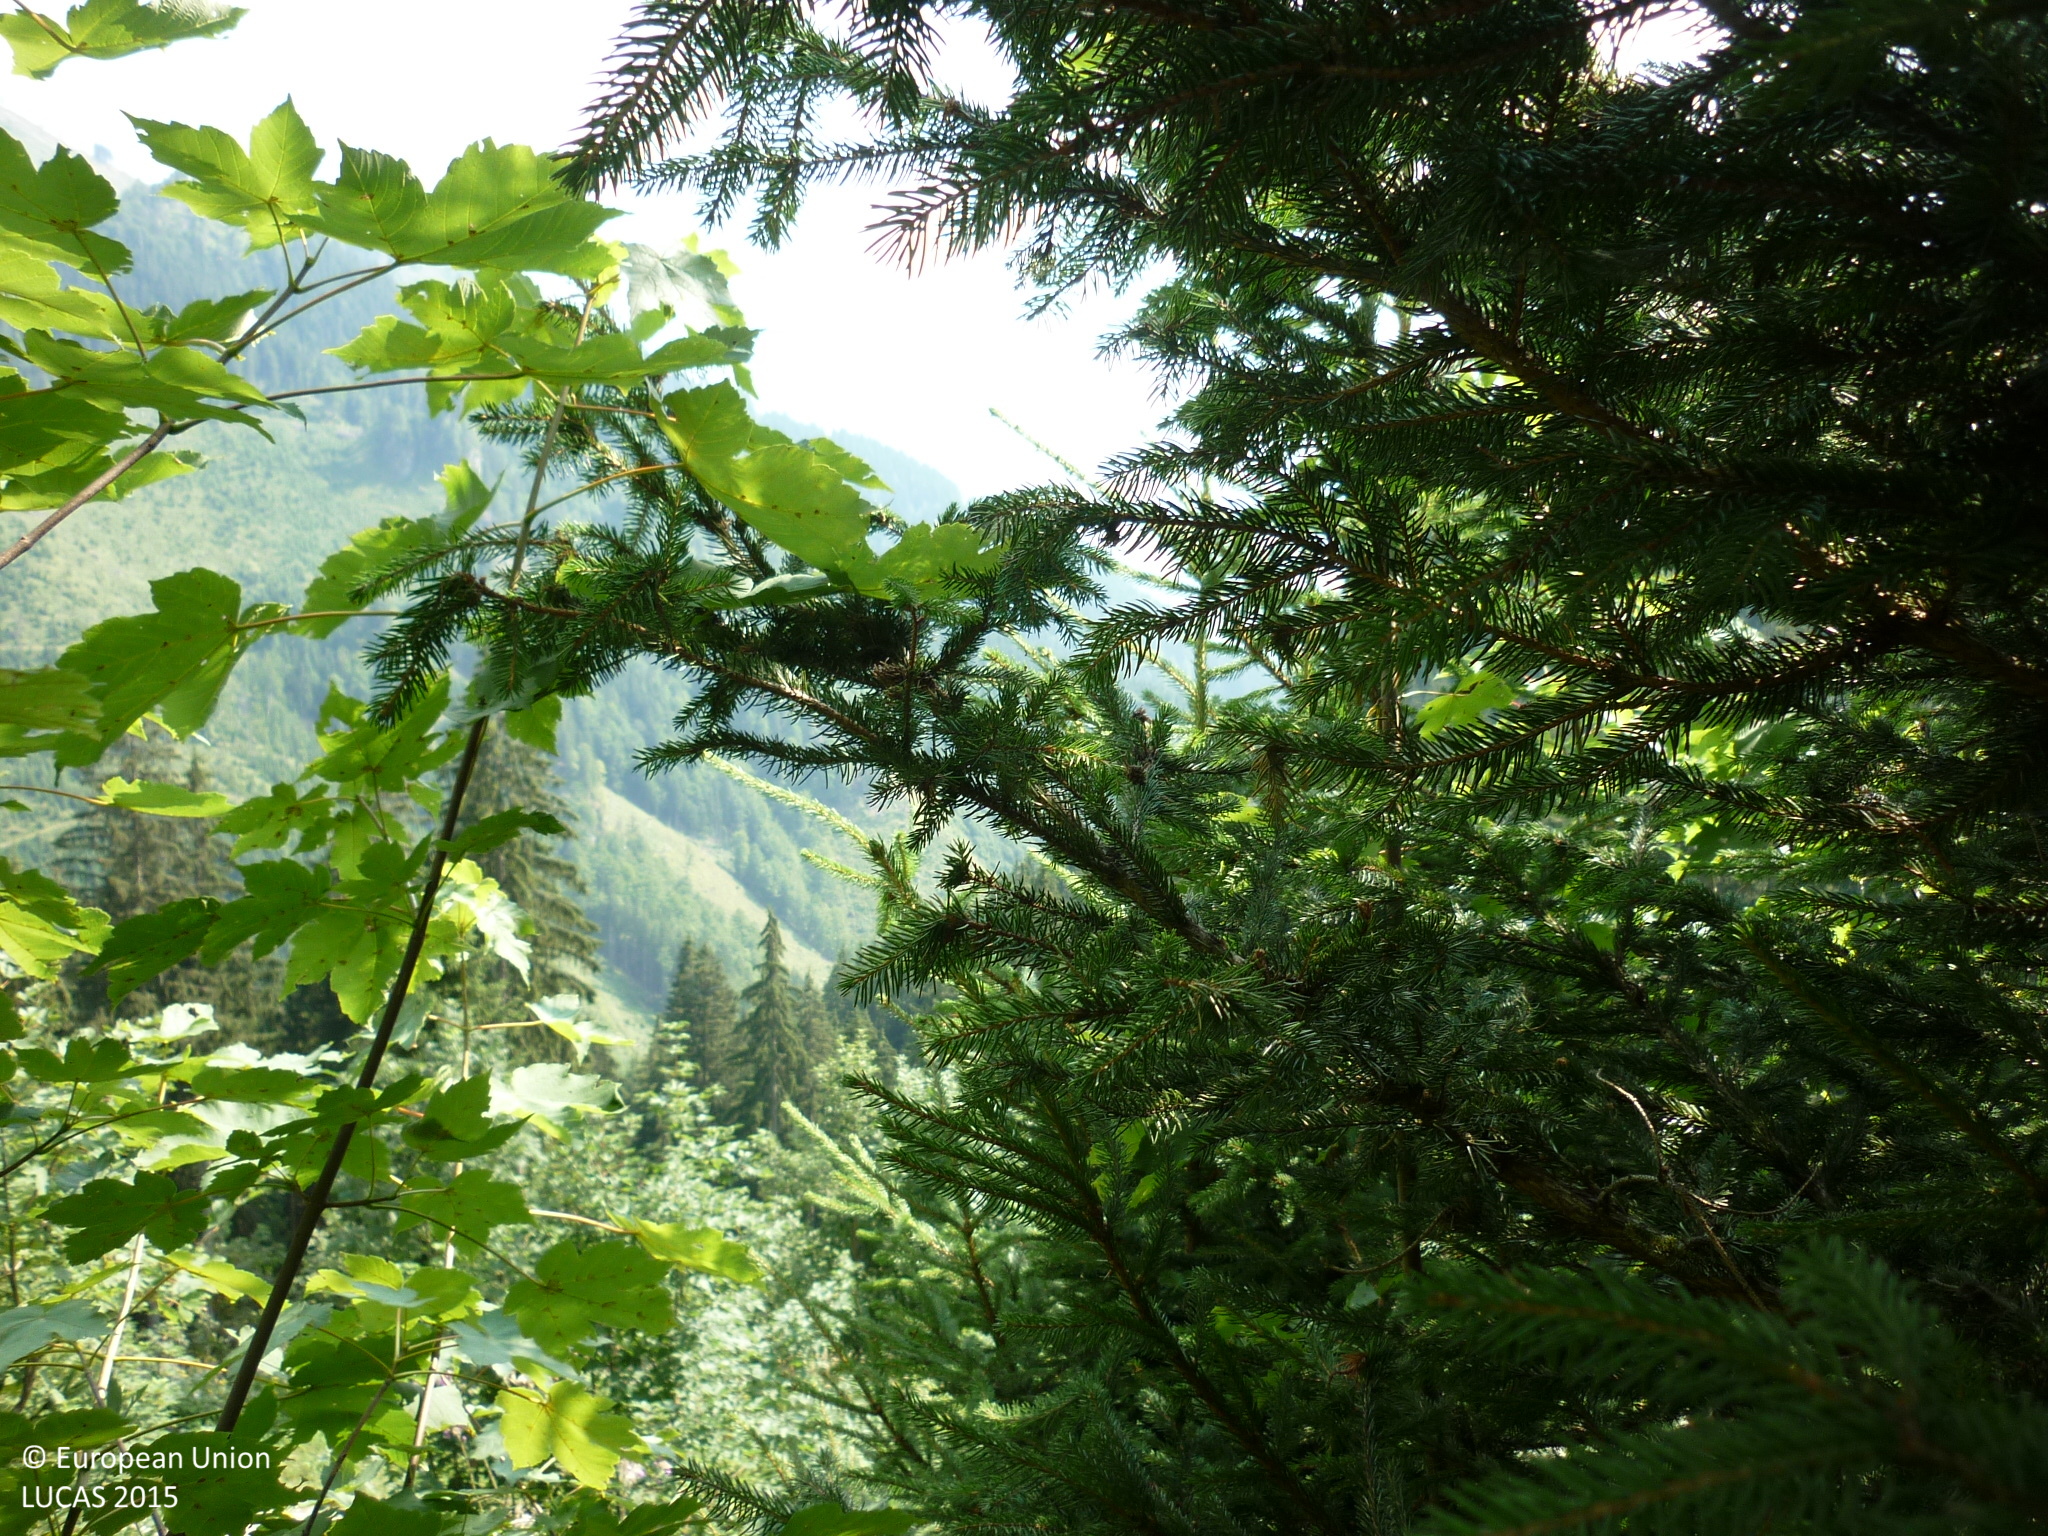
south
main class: Woodland
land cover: Spruce dominated mixed woodland
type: alpine coniferous forest
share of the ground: > 75 %
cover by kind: coniferous forest trees 40 %, broadleaved forest trees 40 %, shrubs 10 %, herbaceous plants 10 %
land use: Forestry
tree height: > 5 m
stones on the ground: 10 - 25 %
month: August
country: AT
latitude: 47.7692
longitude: 14.5498
